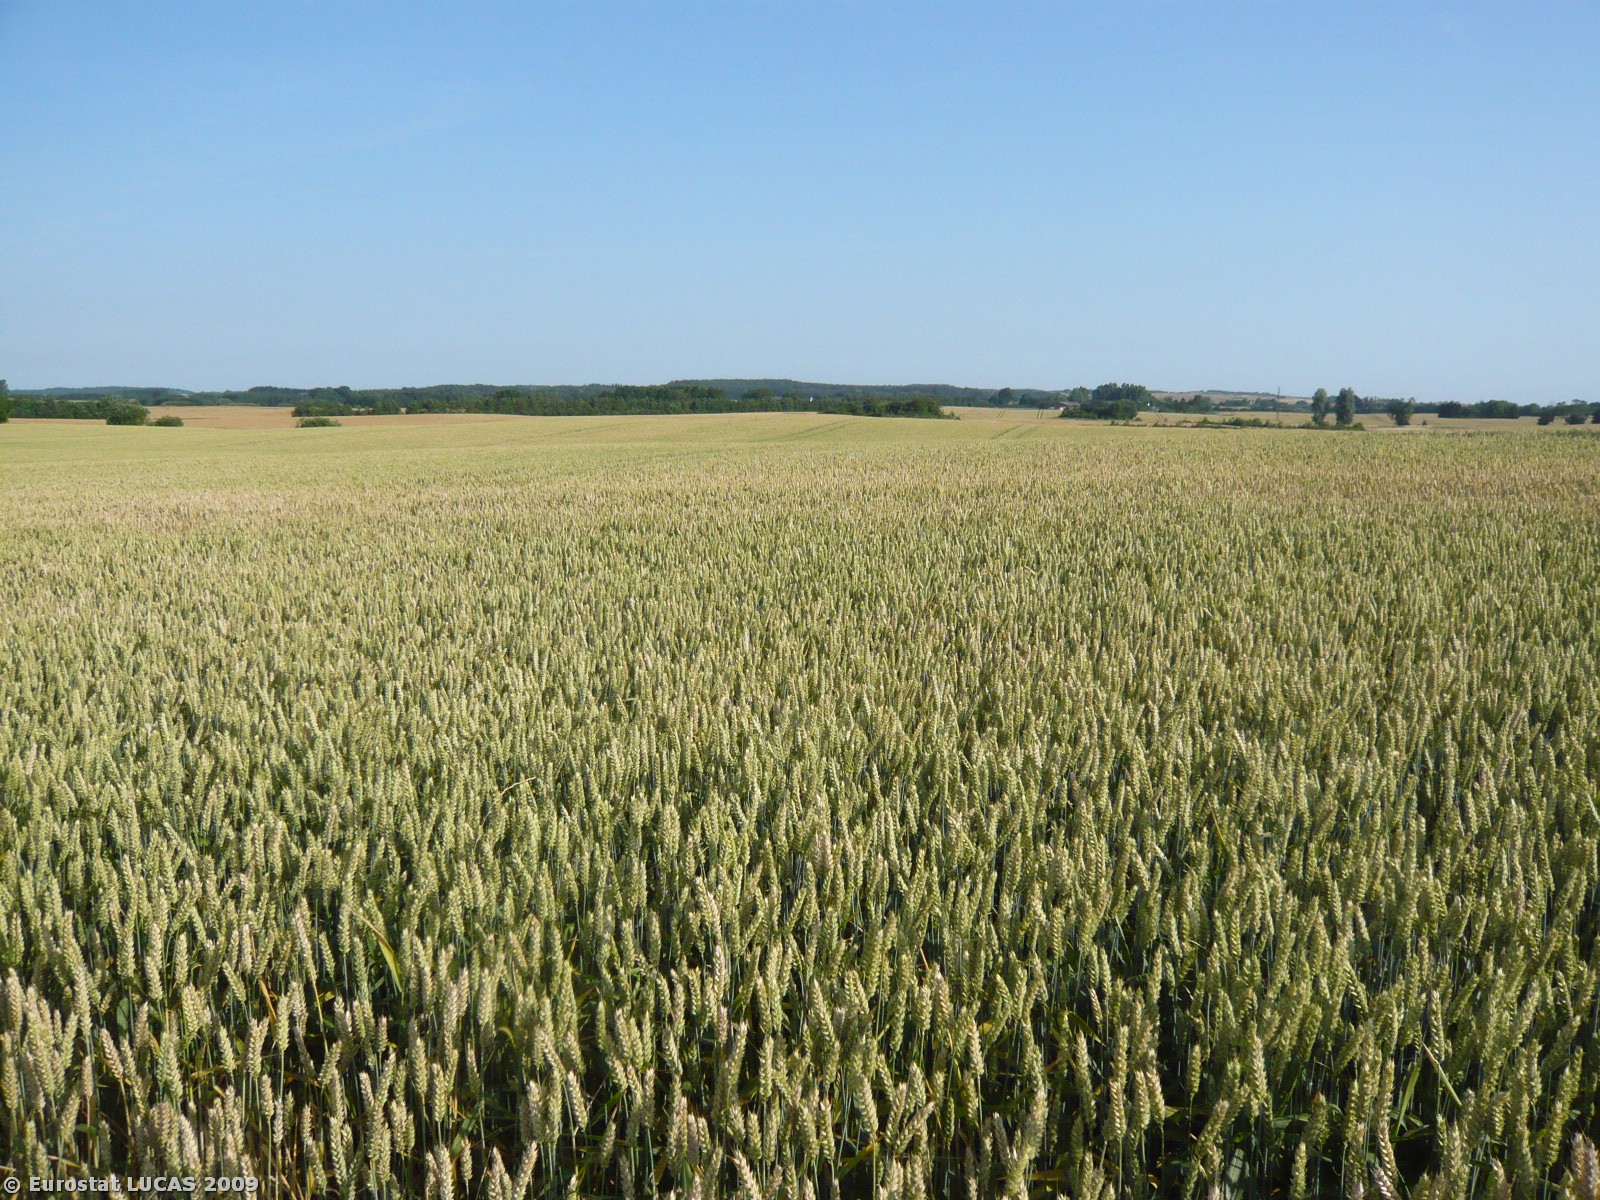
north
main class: Cropland
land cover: Common wheat
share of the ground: > 75 %
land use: Agriculture (excluding fallow land and kitchen gardens)
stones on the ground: < 10 %
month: July
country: DK
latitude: 55.5832
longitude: 11.6960
